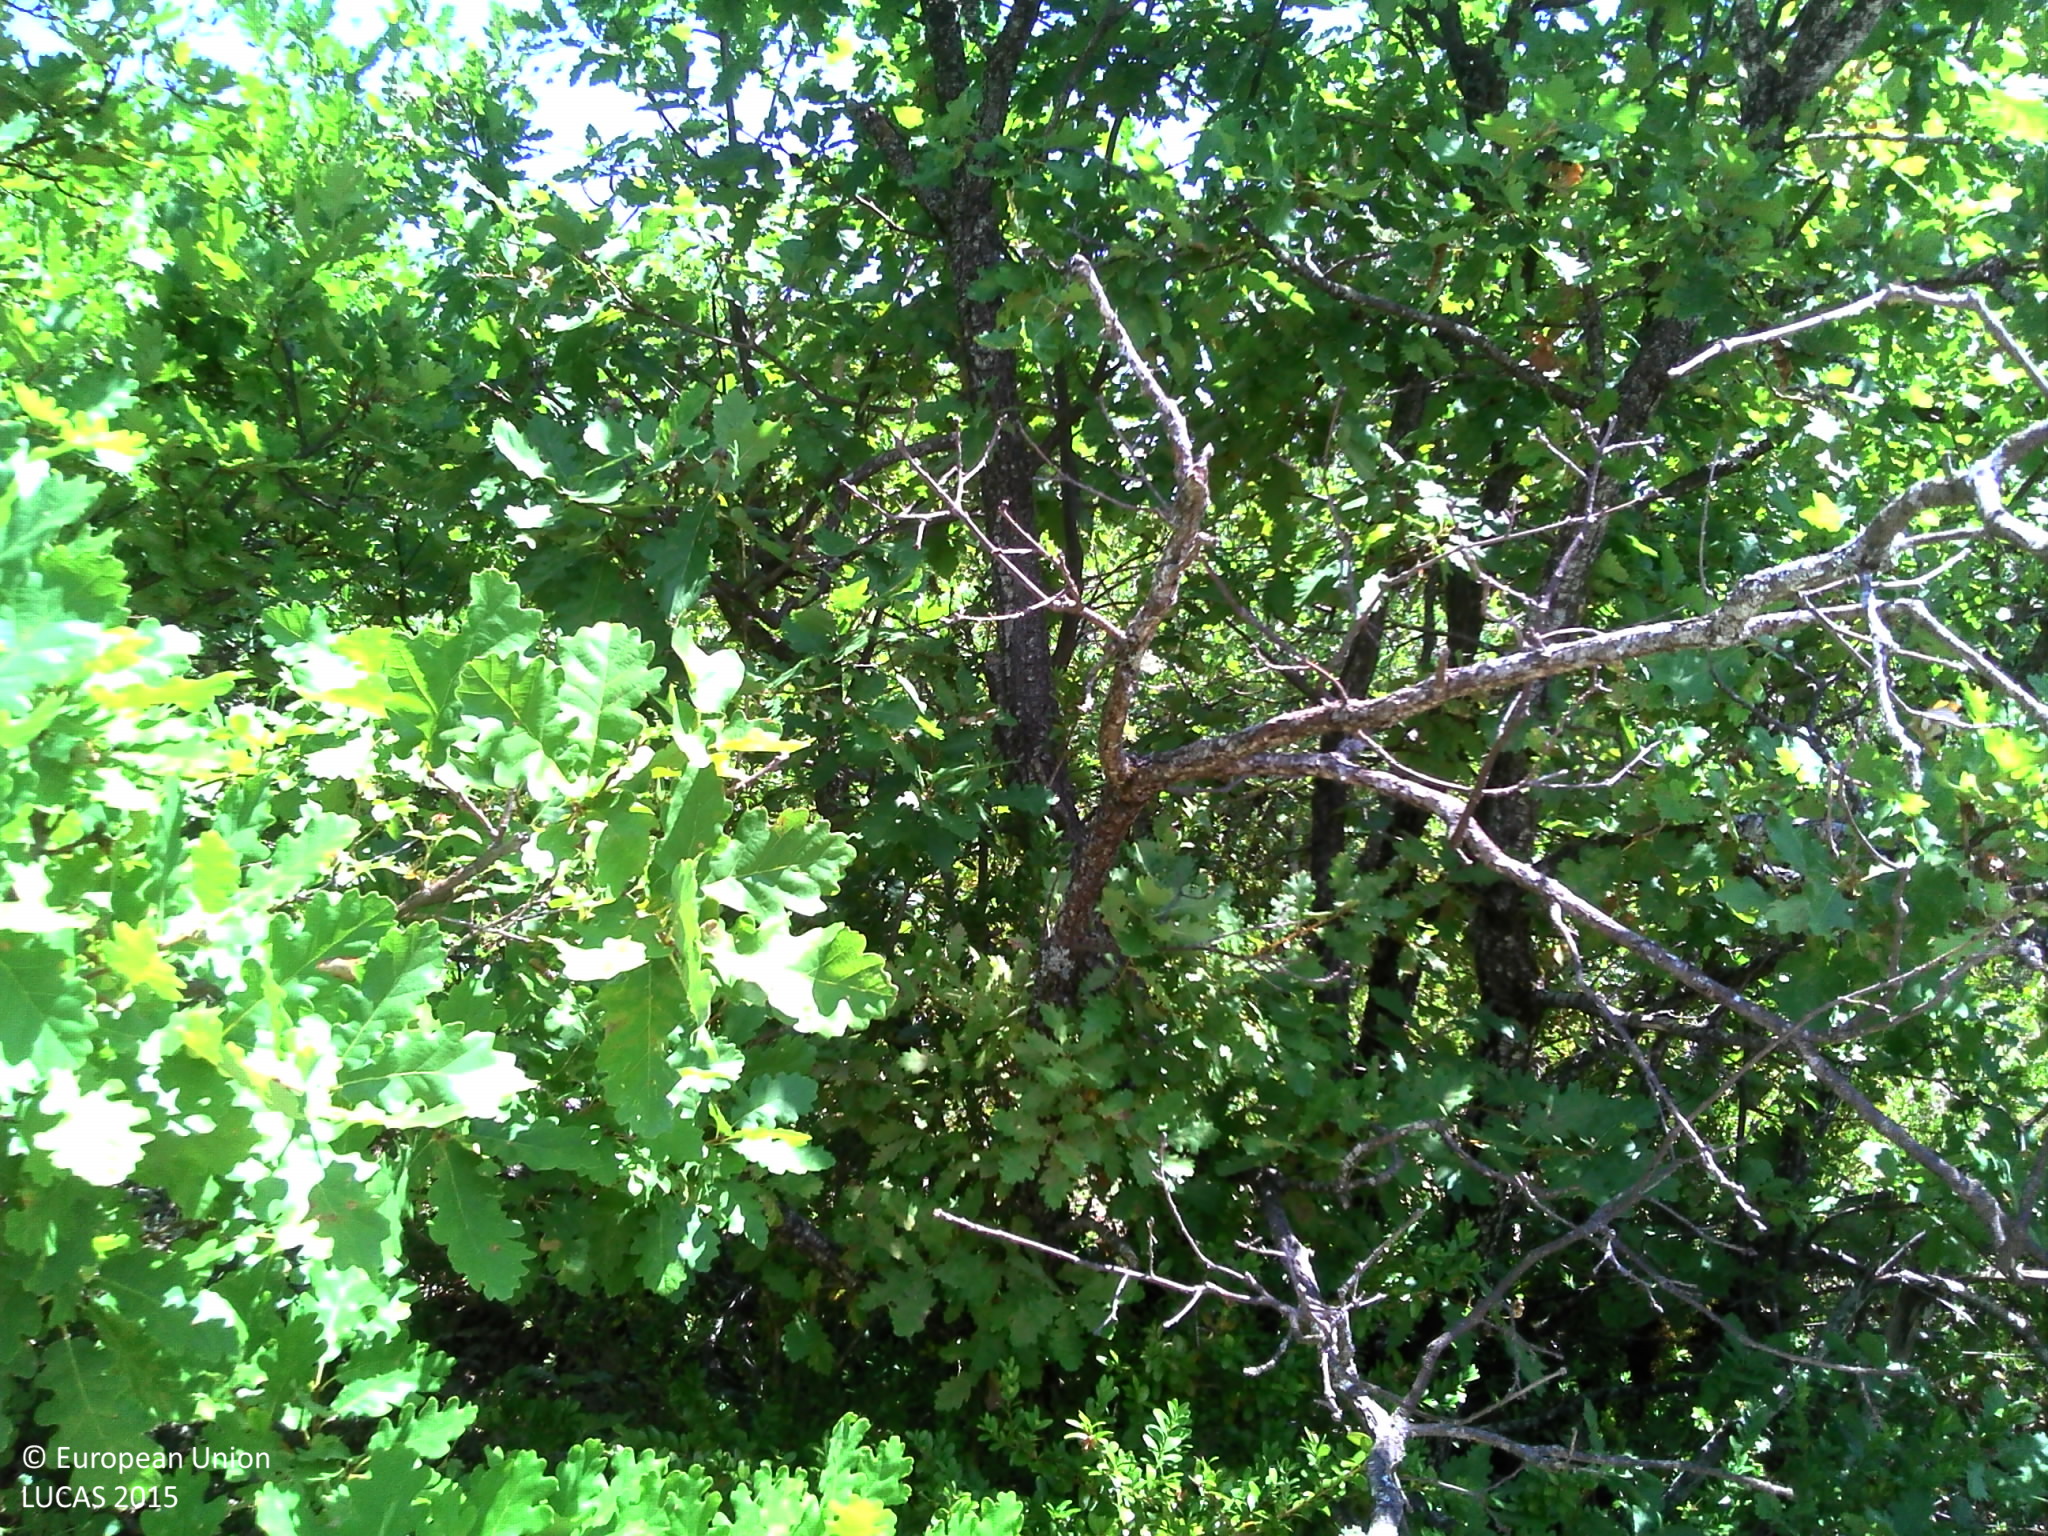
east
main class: Woodland
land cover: Broadleaved woodland
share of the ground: > 75 %
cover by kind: broadleaved forest trees 60 %, shrubs 20 %, herbaceous plants 10 %, unconsolidated bare surface 10 %
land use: Semi-natural and natural areas not in use
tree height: < 5 m
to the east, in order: Broadleaved woodland; Tracks; Broadleaved woodland; Tracks; Broadleaved woodland; Permanent industrial crops
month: July
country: FR
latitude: 44.1029
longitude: 5.3734
